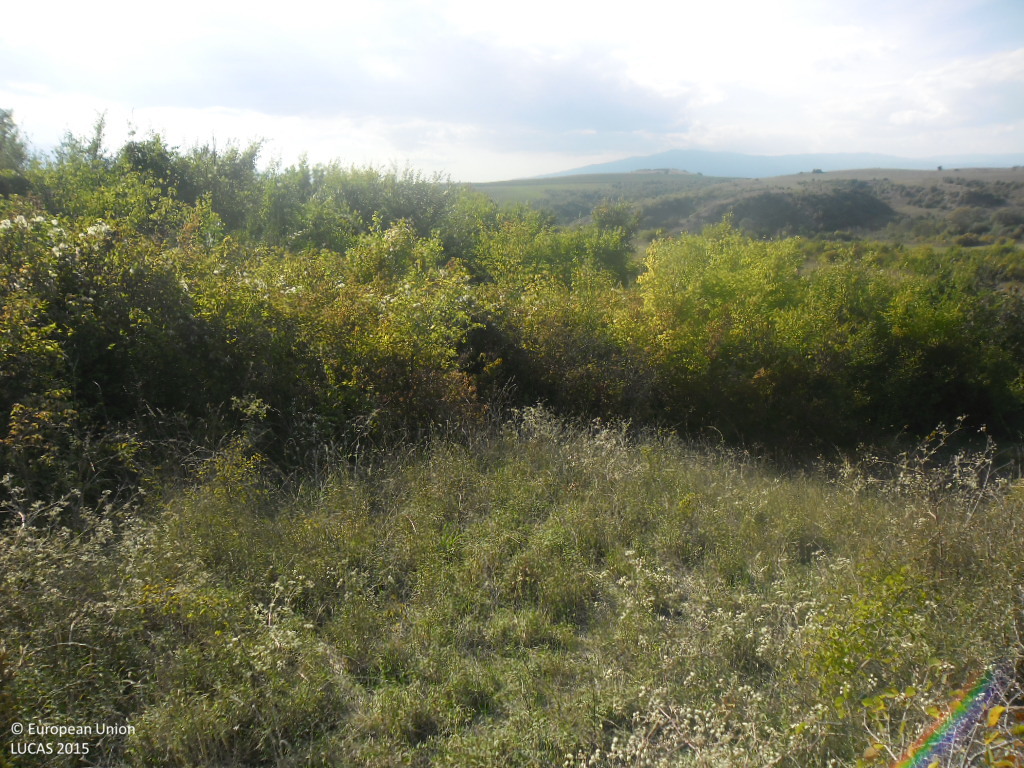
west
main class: Shrubland
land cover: Shrubland with sparse tree cover
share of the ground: > 75 %
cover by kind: shrubs 60 %, herbaceous plants 35 %, broadleaved forest trees 5 %
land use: Agriculture (excluding fallow land and kitchen gardens)
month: October
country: BG
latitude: 41.4315
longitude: 23.3888
